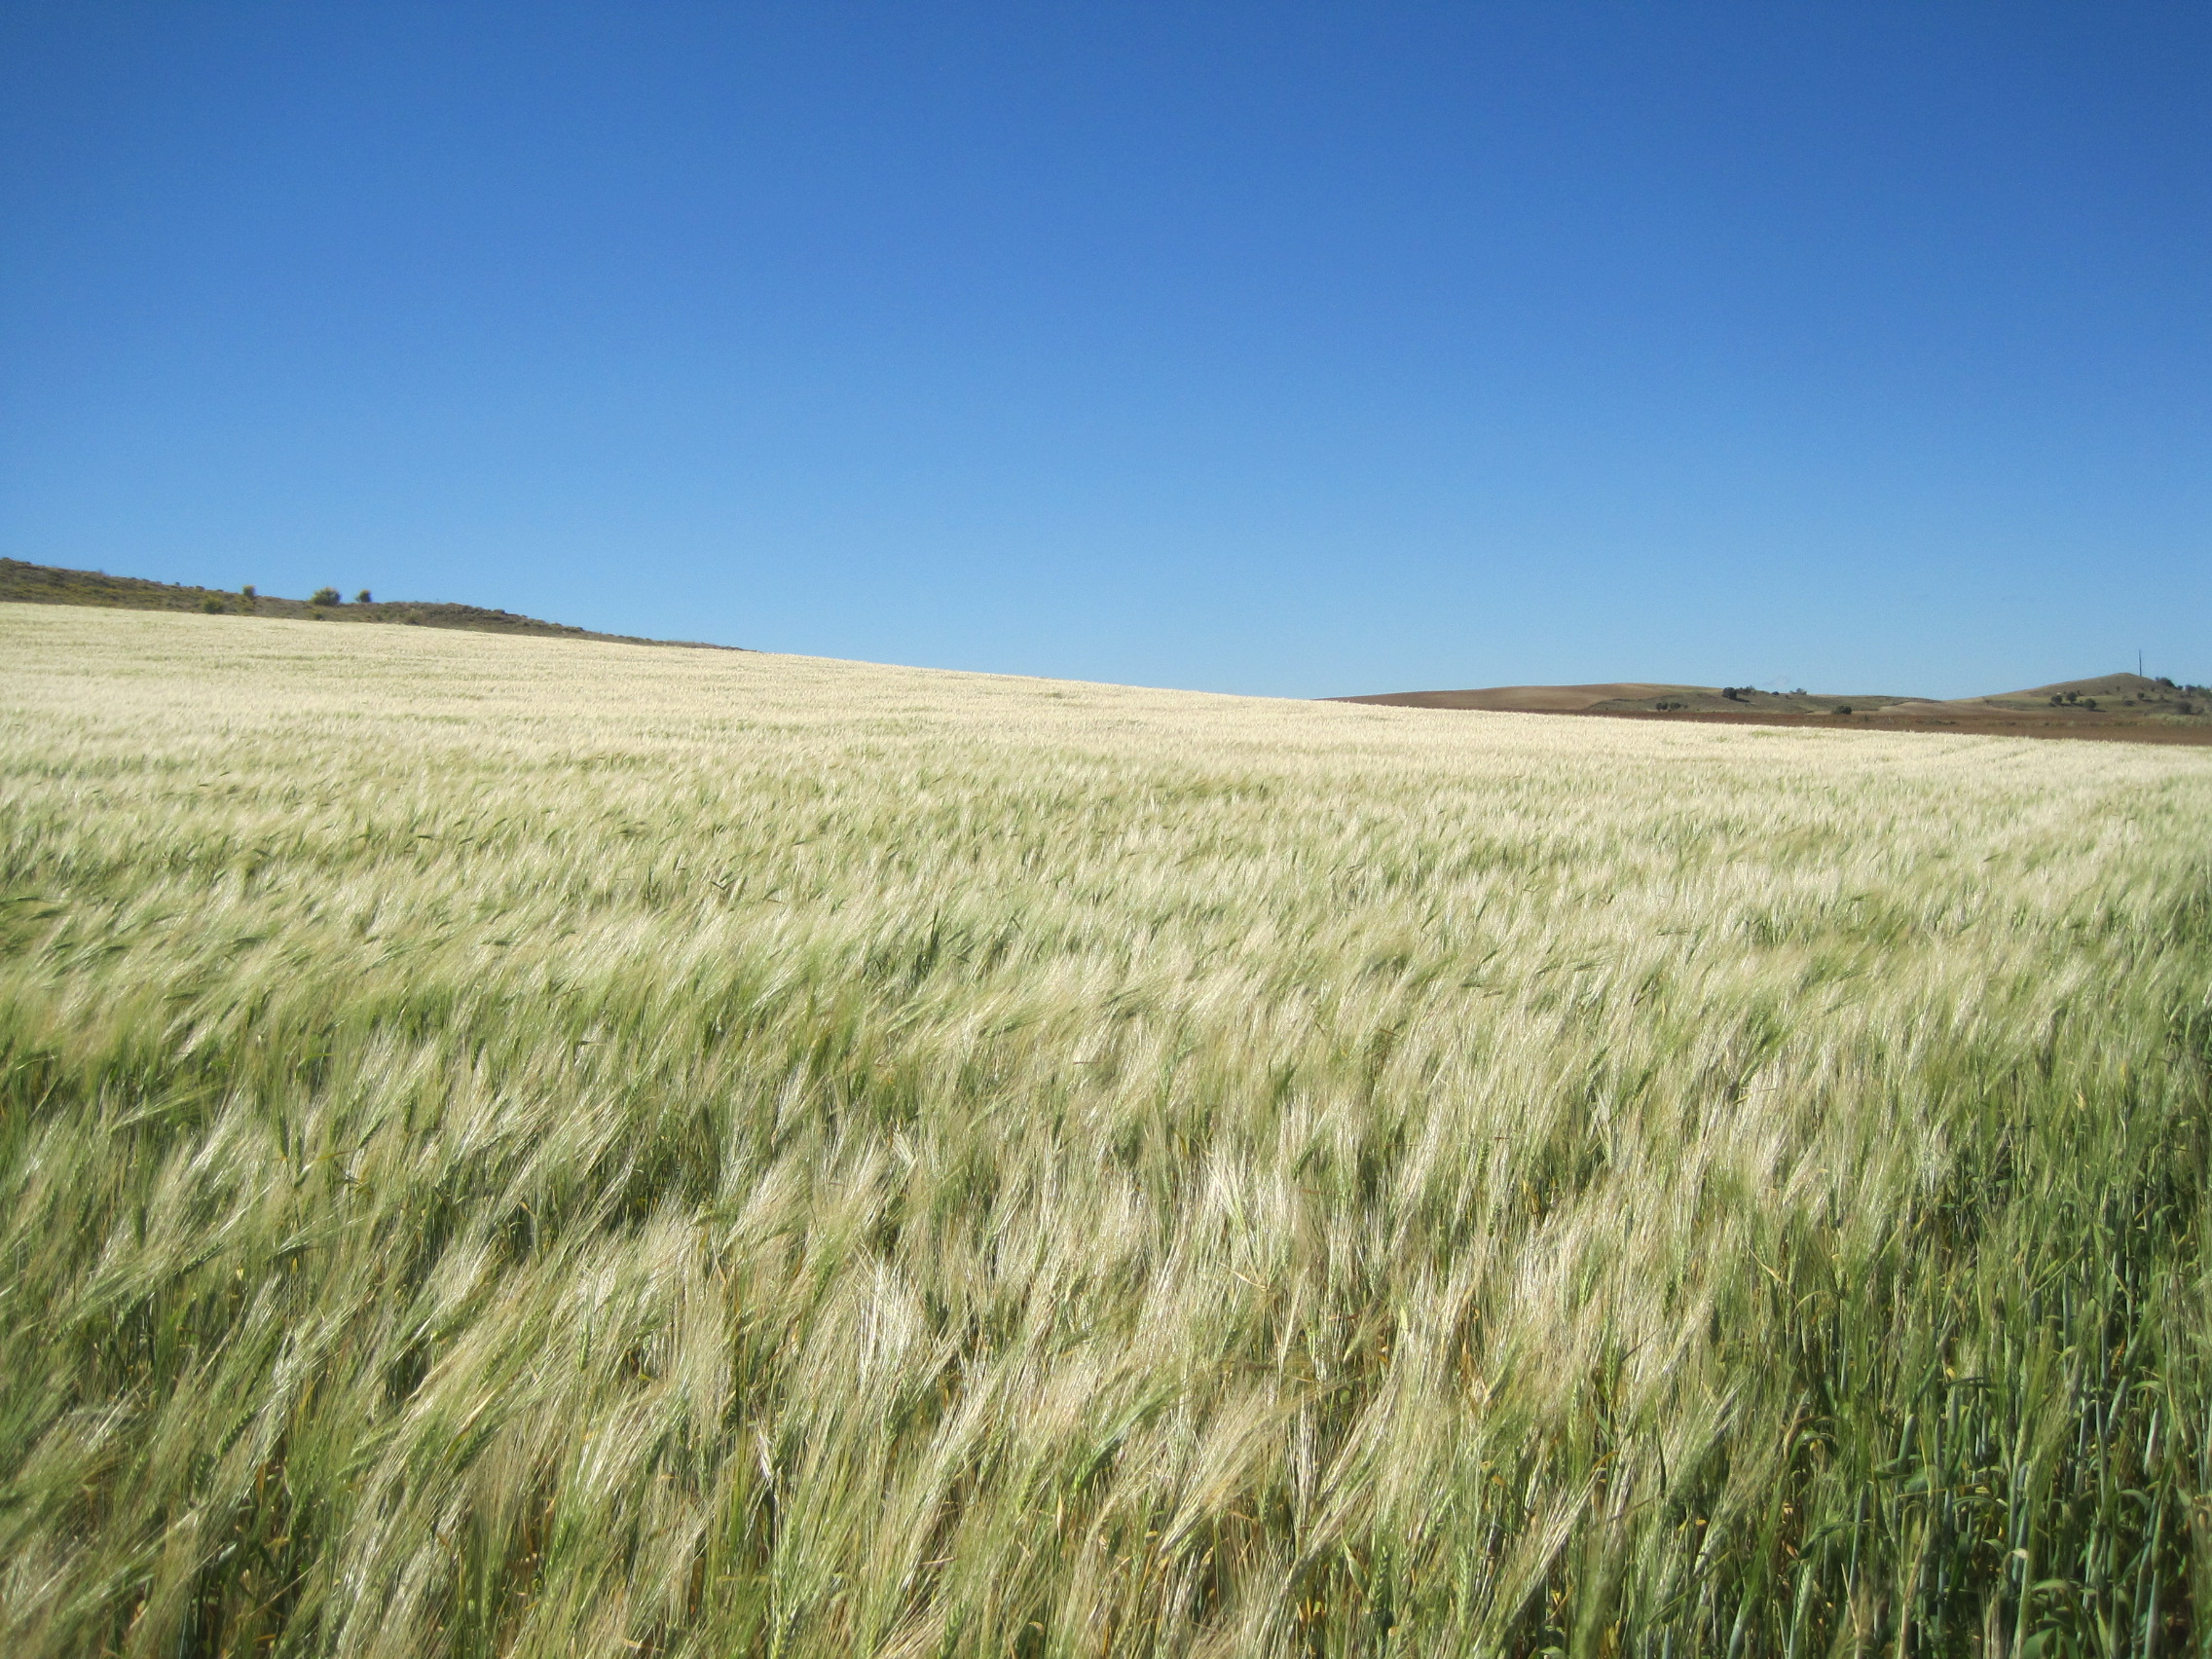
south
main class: Cropland
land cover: Common wheat
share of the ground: > 75 %
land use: Agriculture (excluding fallow land and kitchen gardens)
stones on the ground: < 10 %
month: May
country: ES
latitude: 41.1512
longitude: -5.3134
